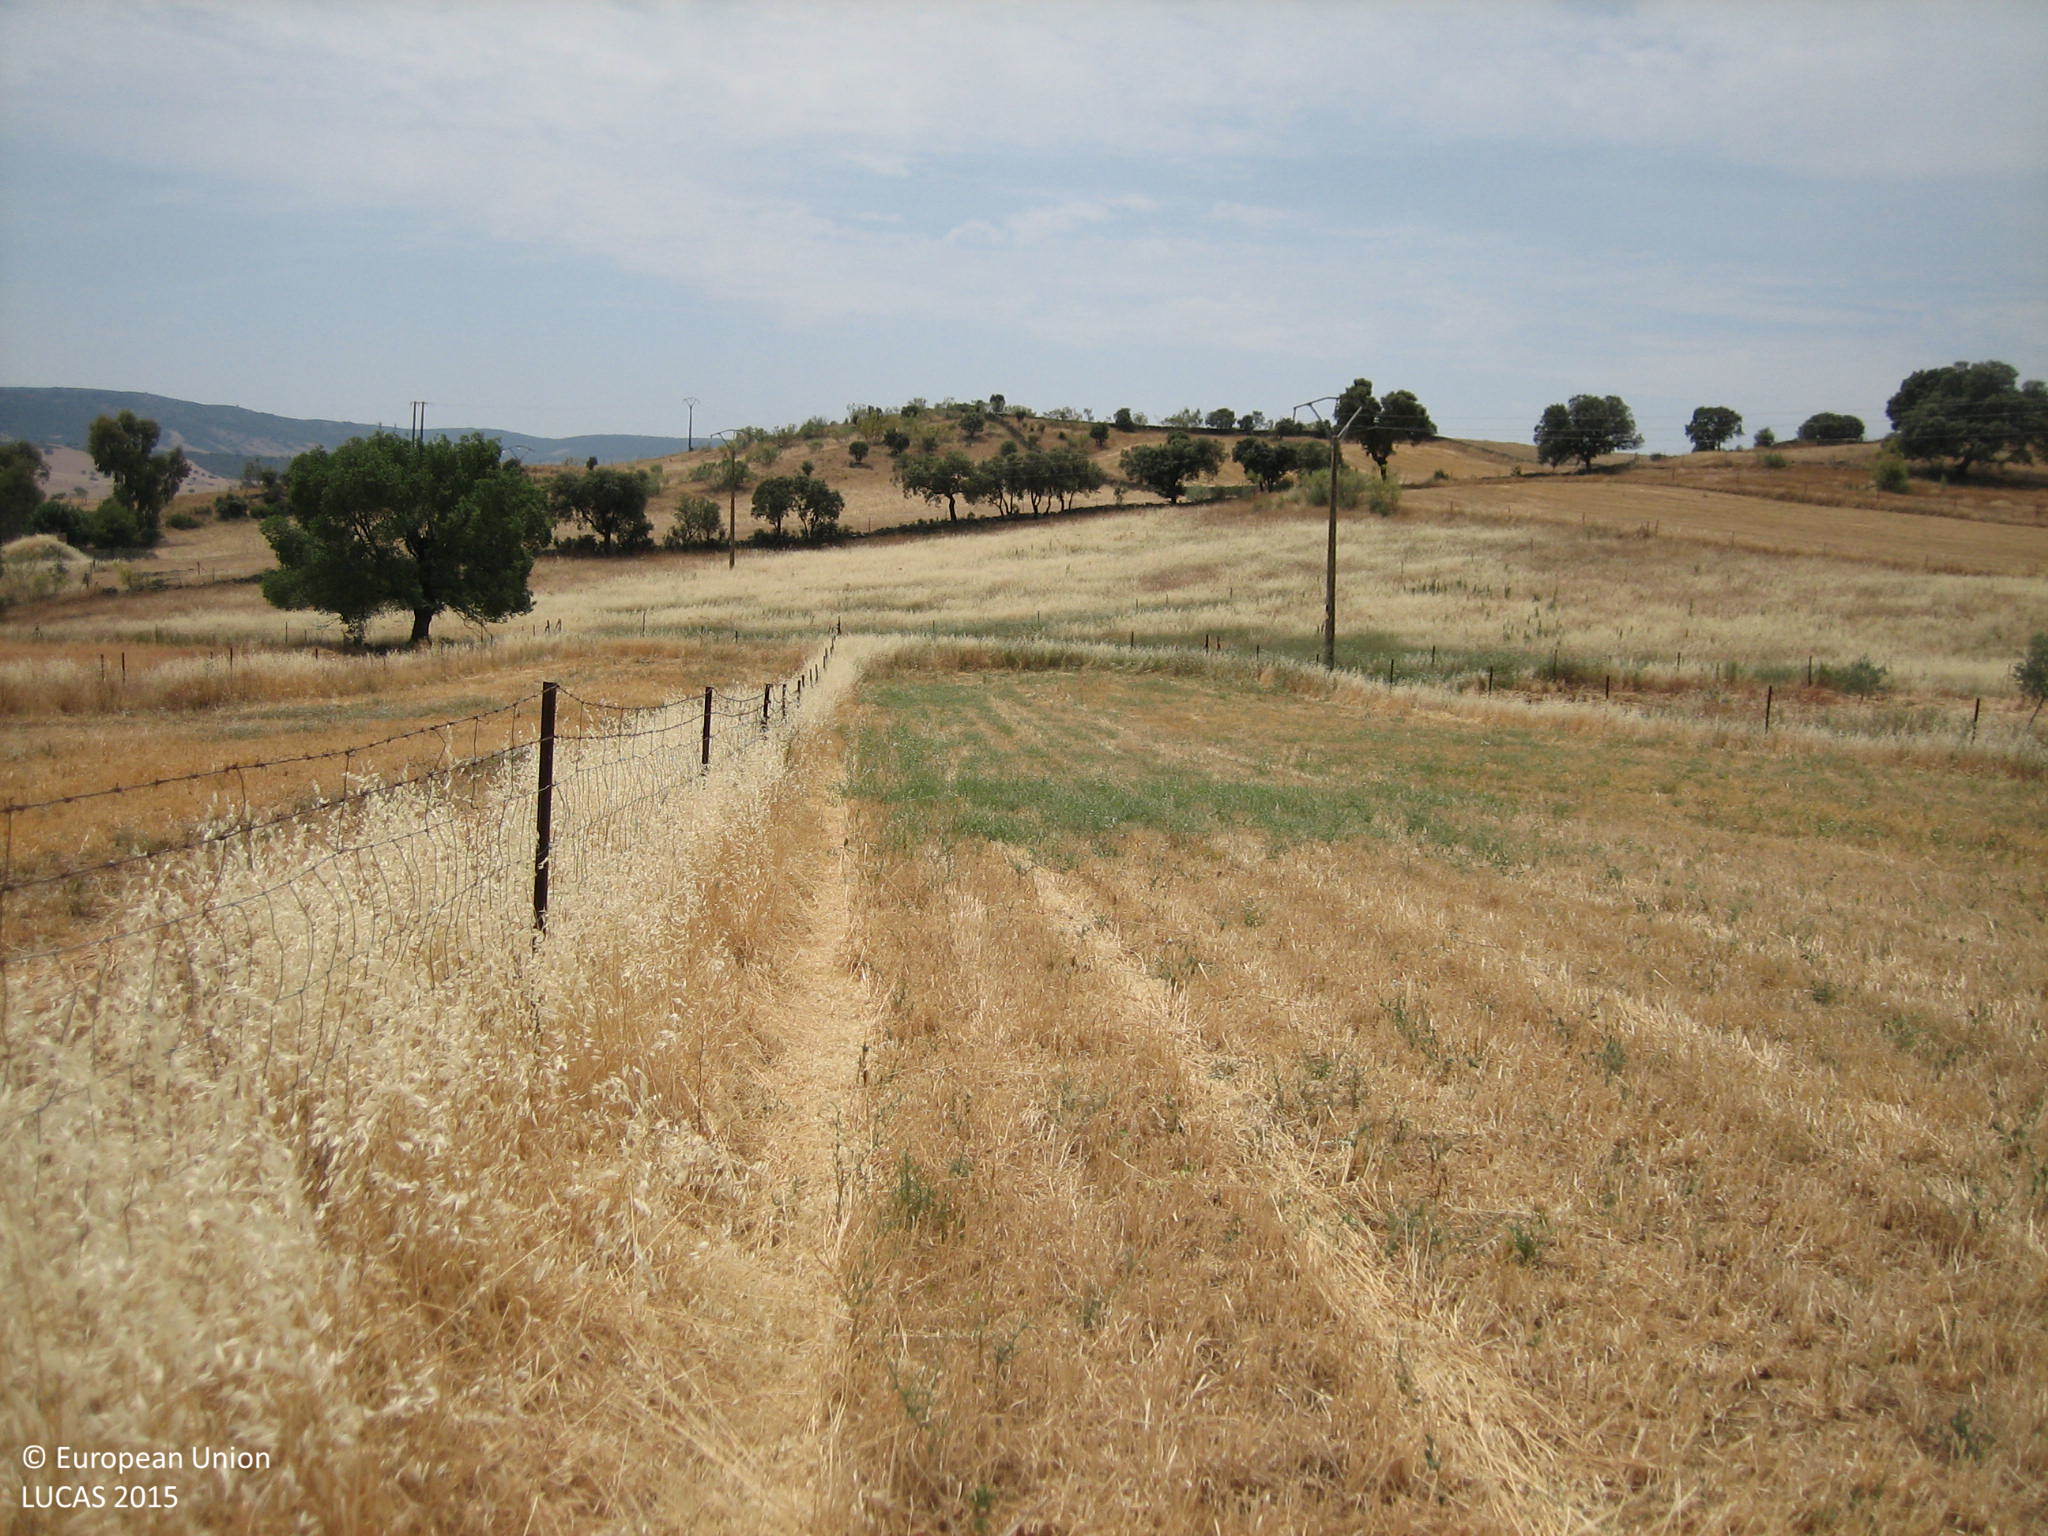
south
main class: Cropland
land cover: Oats
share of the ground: 25 - 50 %
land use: Agriculture (excluding fallow land and kitchen gardens)
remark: Harvested field
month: June
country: ES
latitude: 39.2173
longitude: -4.5212
